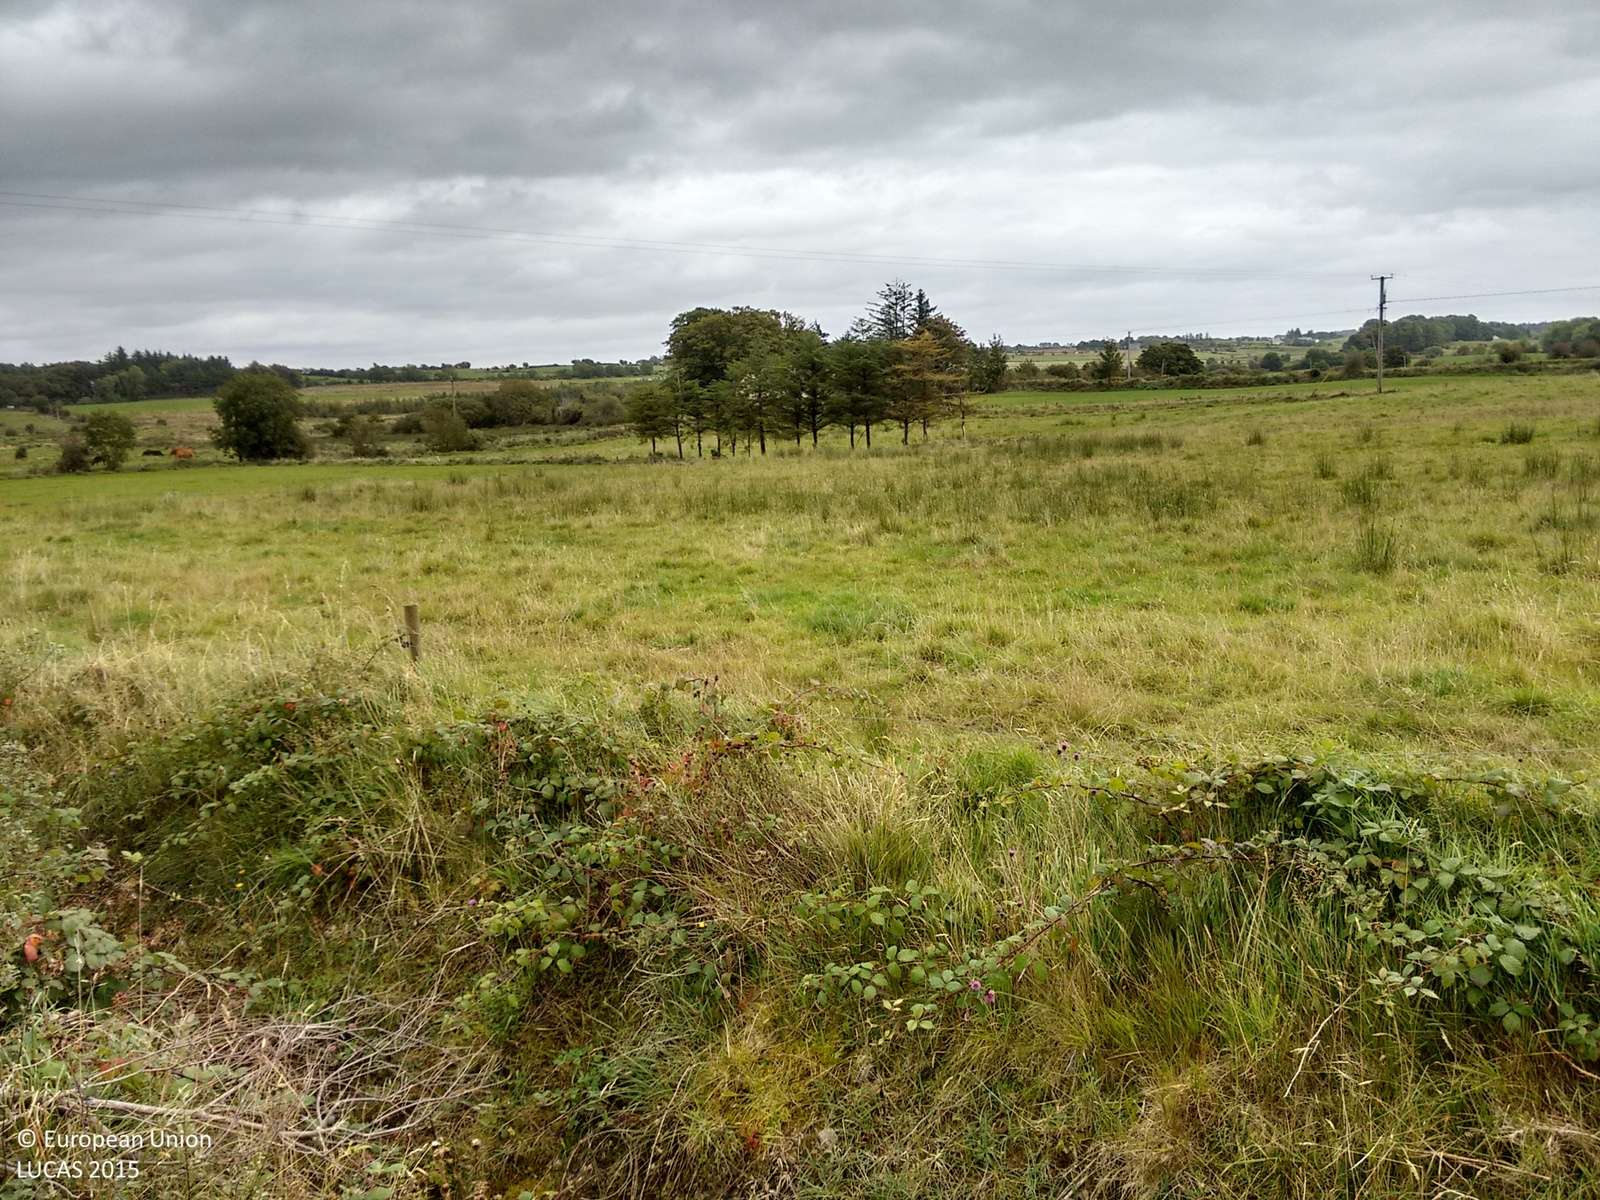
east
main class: Grassland
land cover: Grassland without tree/shrub cover
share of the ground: > 75 %
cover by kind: herbaceous plants 100 %
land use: Agriculture (excluding fallow land and kitchen gardens)
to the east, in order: Grassland without tree/shrub cover; Ditches and canals; Grassland without tree/shrub cover; Electric lines; Grassland without tree/shrub cover; Fences; Ditches and canals; Grass margins; Paved roads, cycling and walking lanes; Electric lines; Grass margins; Fences; Grassland without tree/shrub cover; Artificial constructions in urban areas; Spruce dominated coniferous woodland; Grassland without tree/shrub cover; Electric lines; Grassland without tree/shrub cover
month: September
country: IE
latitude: 53.8386
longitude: -8.8843
